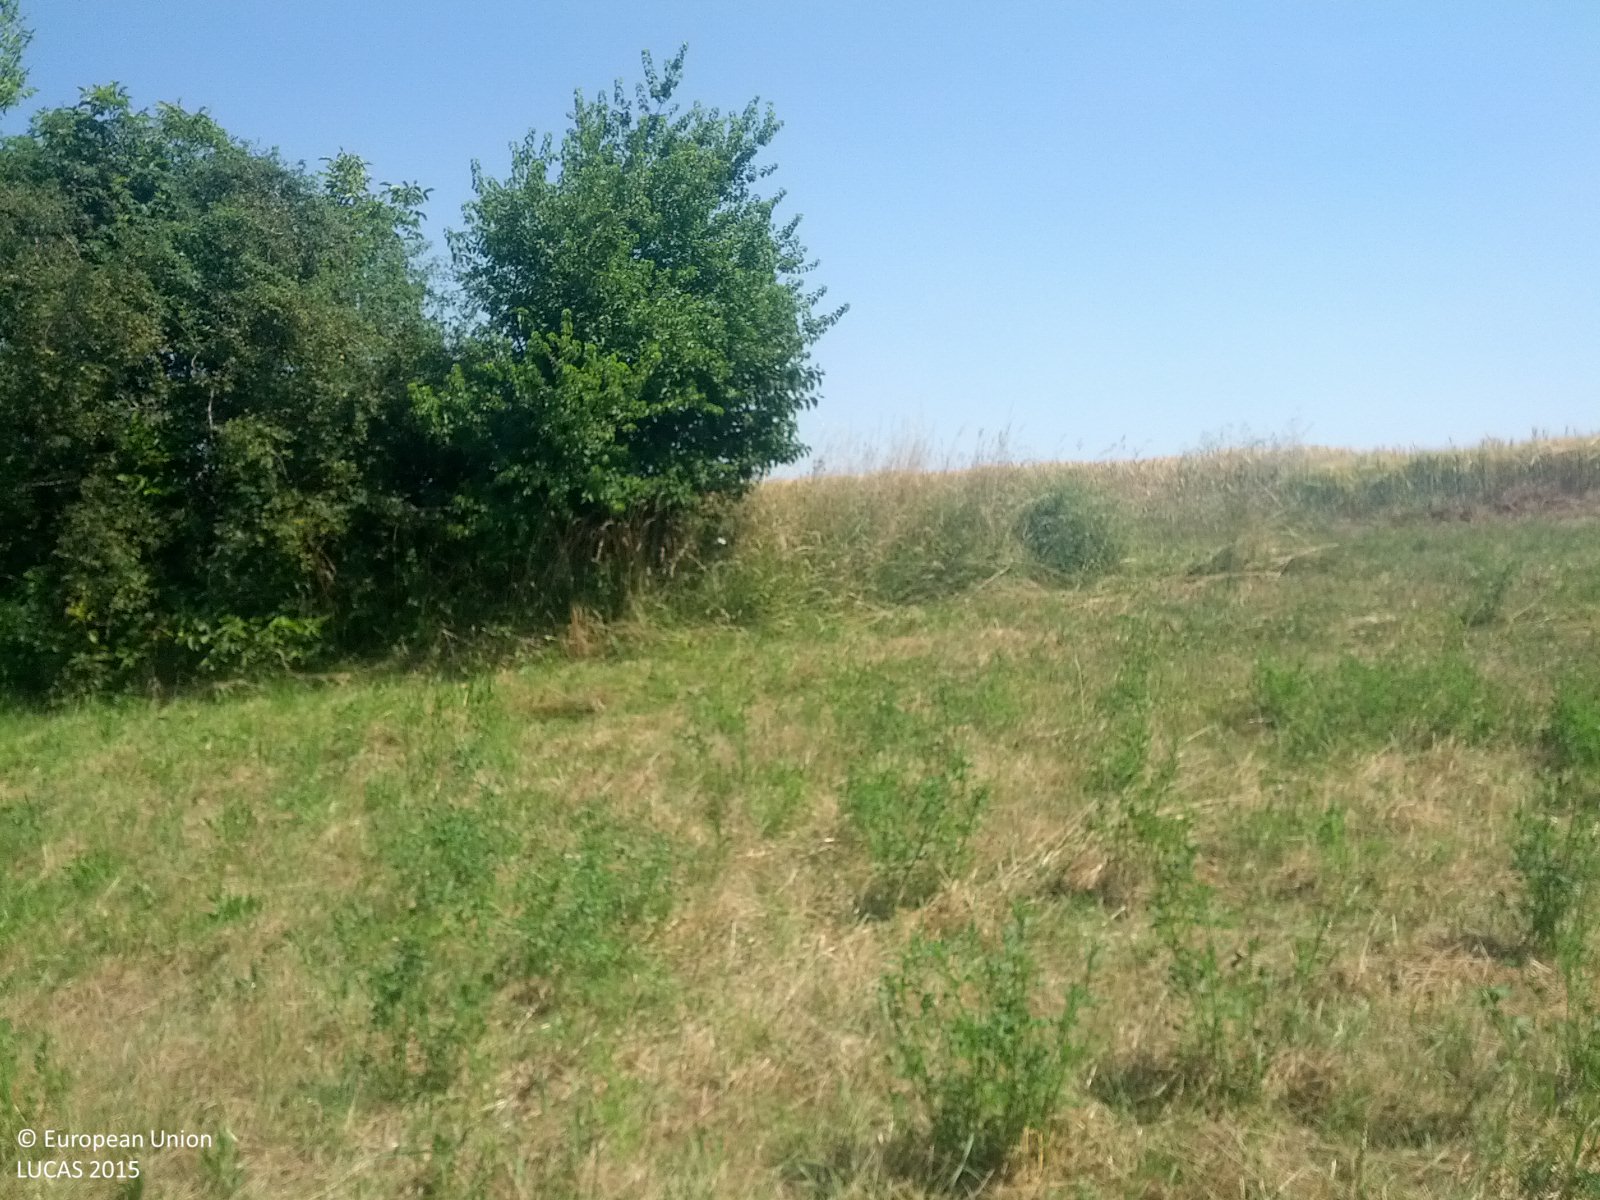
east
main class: Grassland
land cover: Grassland without tree/shrub cover
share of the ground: > 75 %
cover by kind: herbaceous plants 100 %
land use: Agriculture (excluding fallow land and kitchen gardens)
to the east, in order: Grassland without tree/shrub cover; Abandoned hedges; Grass margins; Tracks; Grass margins; Common wheat; Lines of trees; Grass margins; Tracks; Grass margins; Common wheat
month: July
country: AT
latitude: 48.5116
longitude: 16.6260
